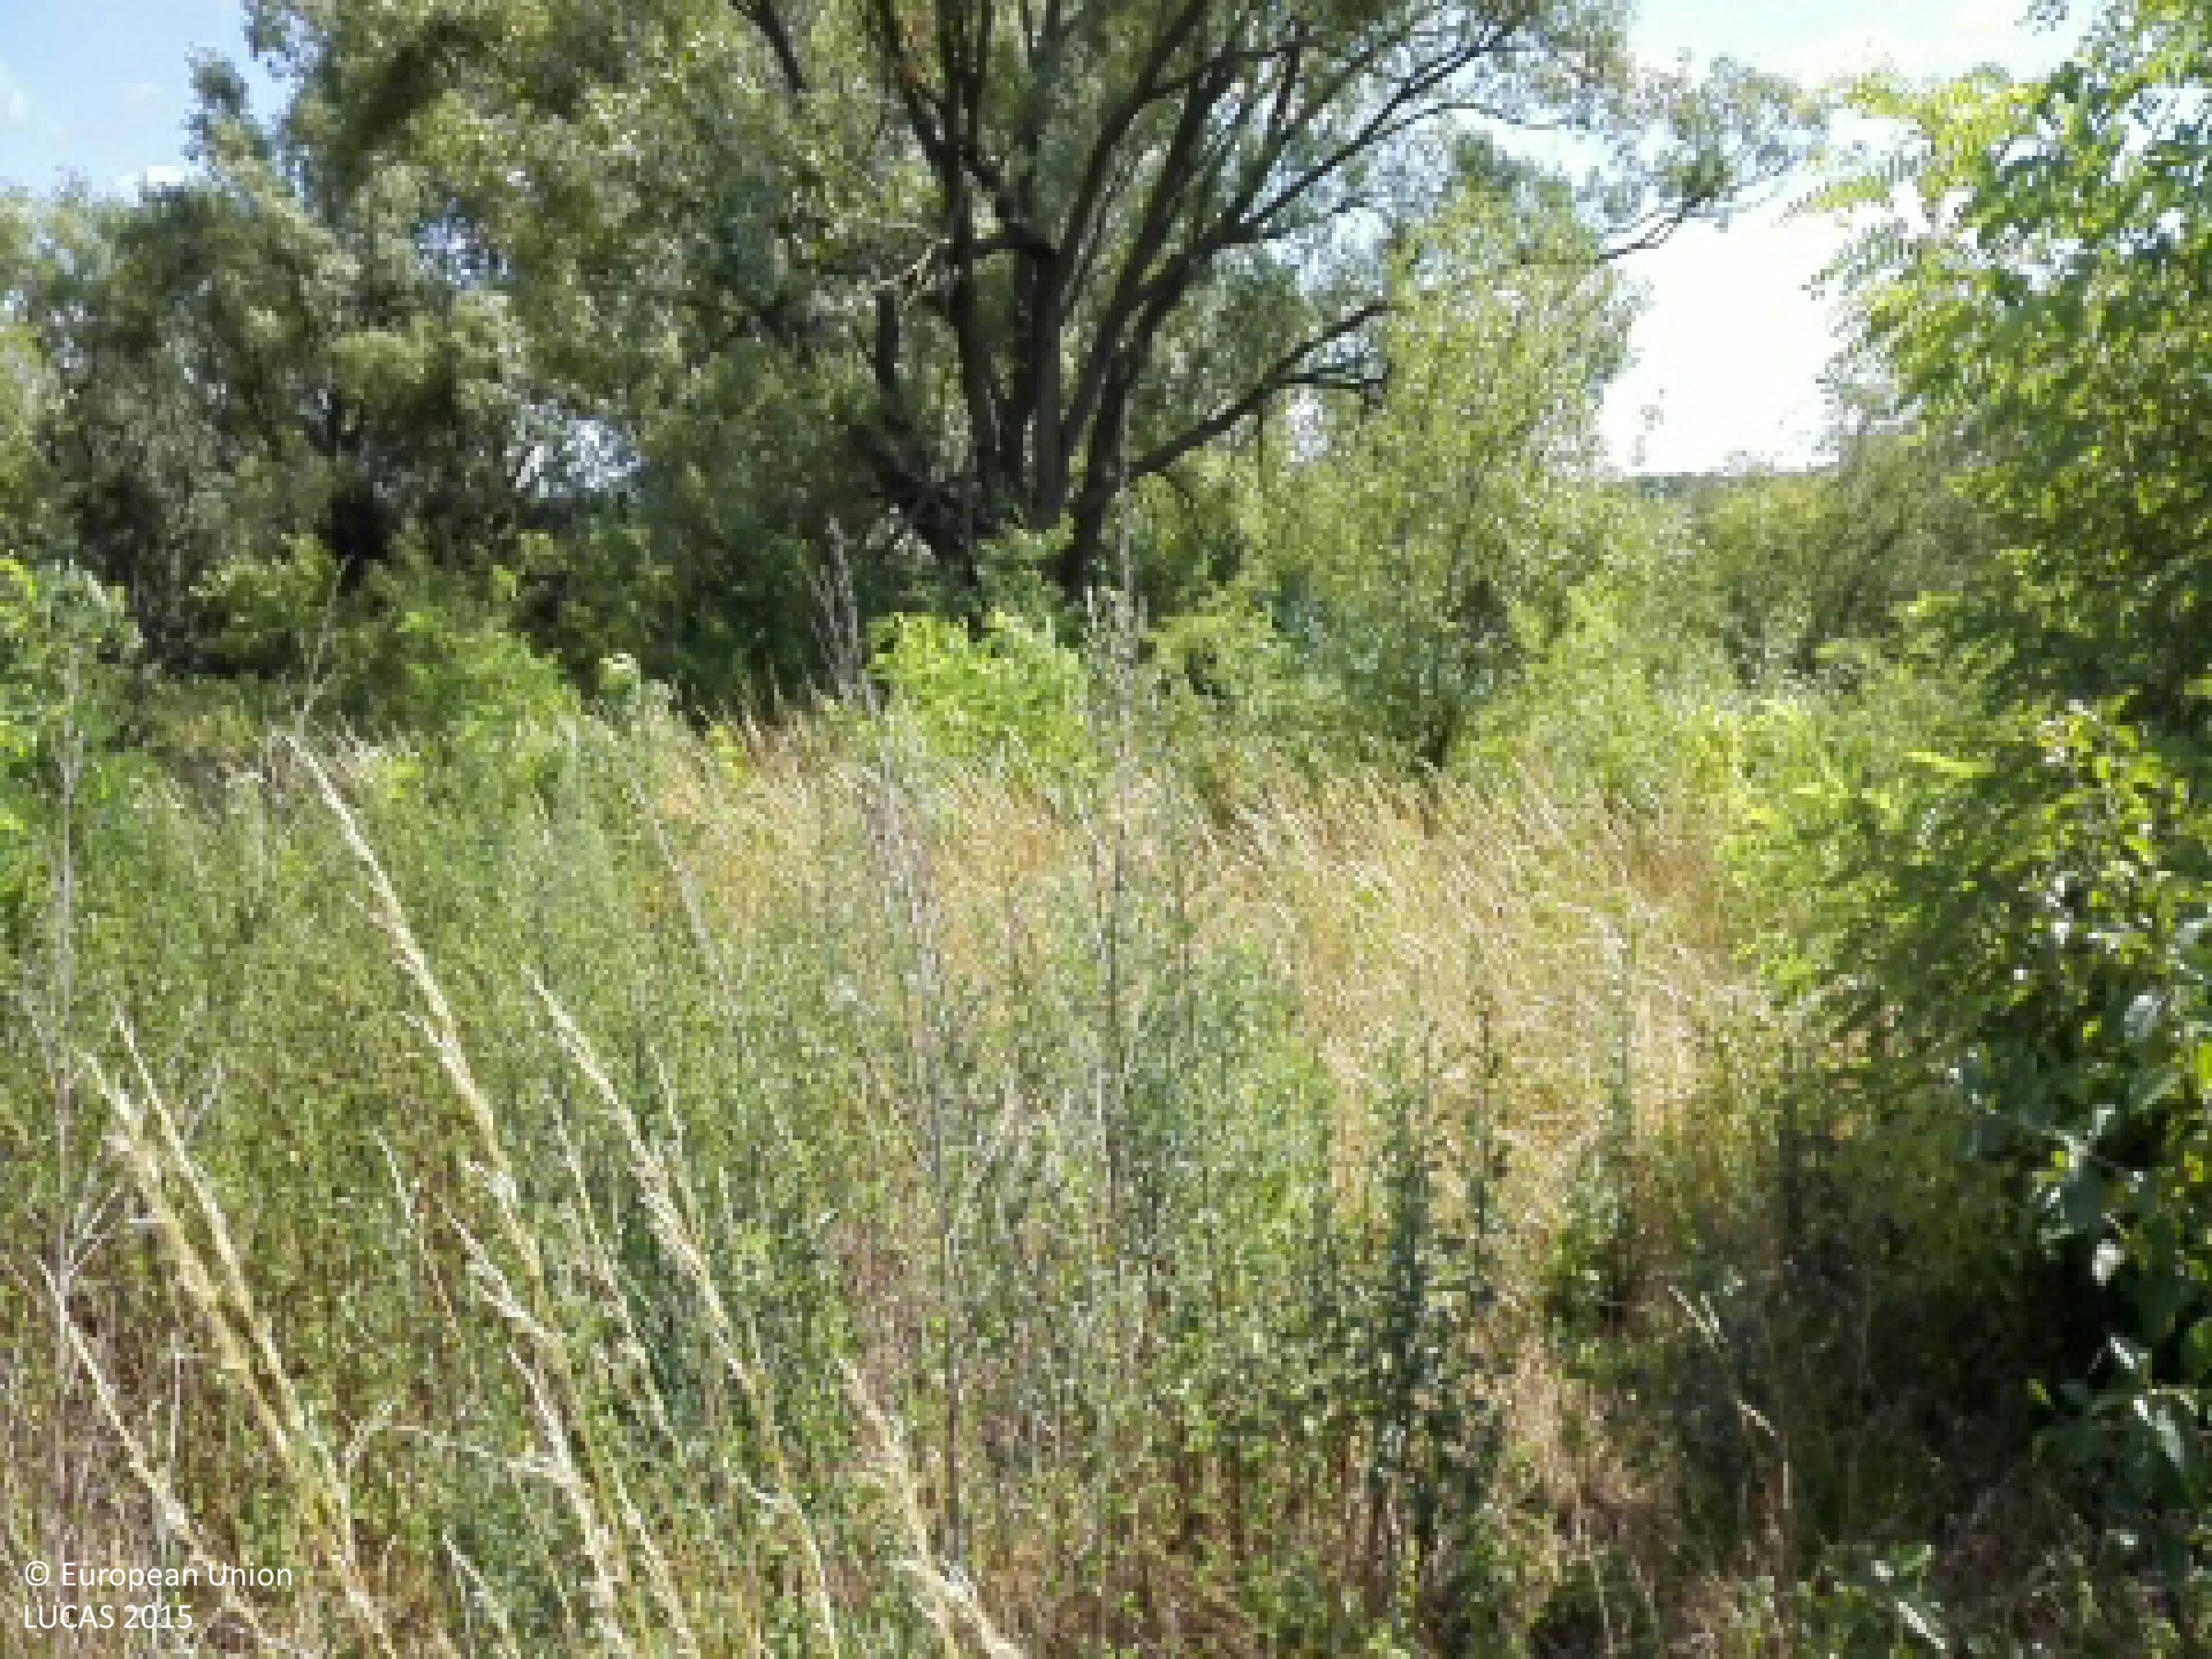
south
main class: Woodland
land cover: Broadleaved woodland
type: mesophytic deciduous forest
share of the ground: 10 - 25 %
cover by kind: herbaceous plants 80 %, broadleaved forest trees 15 %, shrubs 5 %
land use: Semi-natural and natural areas not in use
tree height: > 5 m
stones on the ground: < 10 %
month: July
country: HU
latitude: 47.6652
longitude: 21.7525
